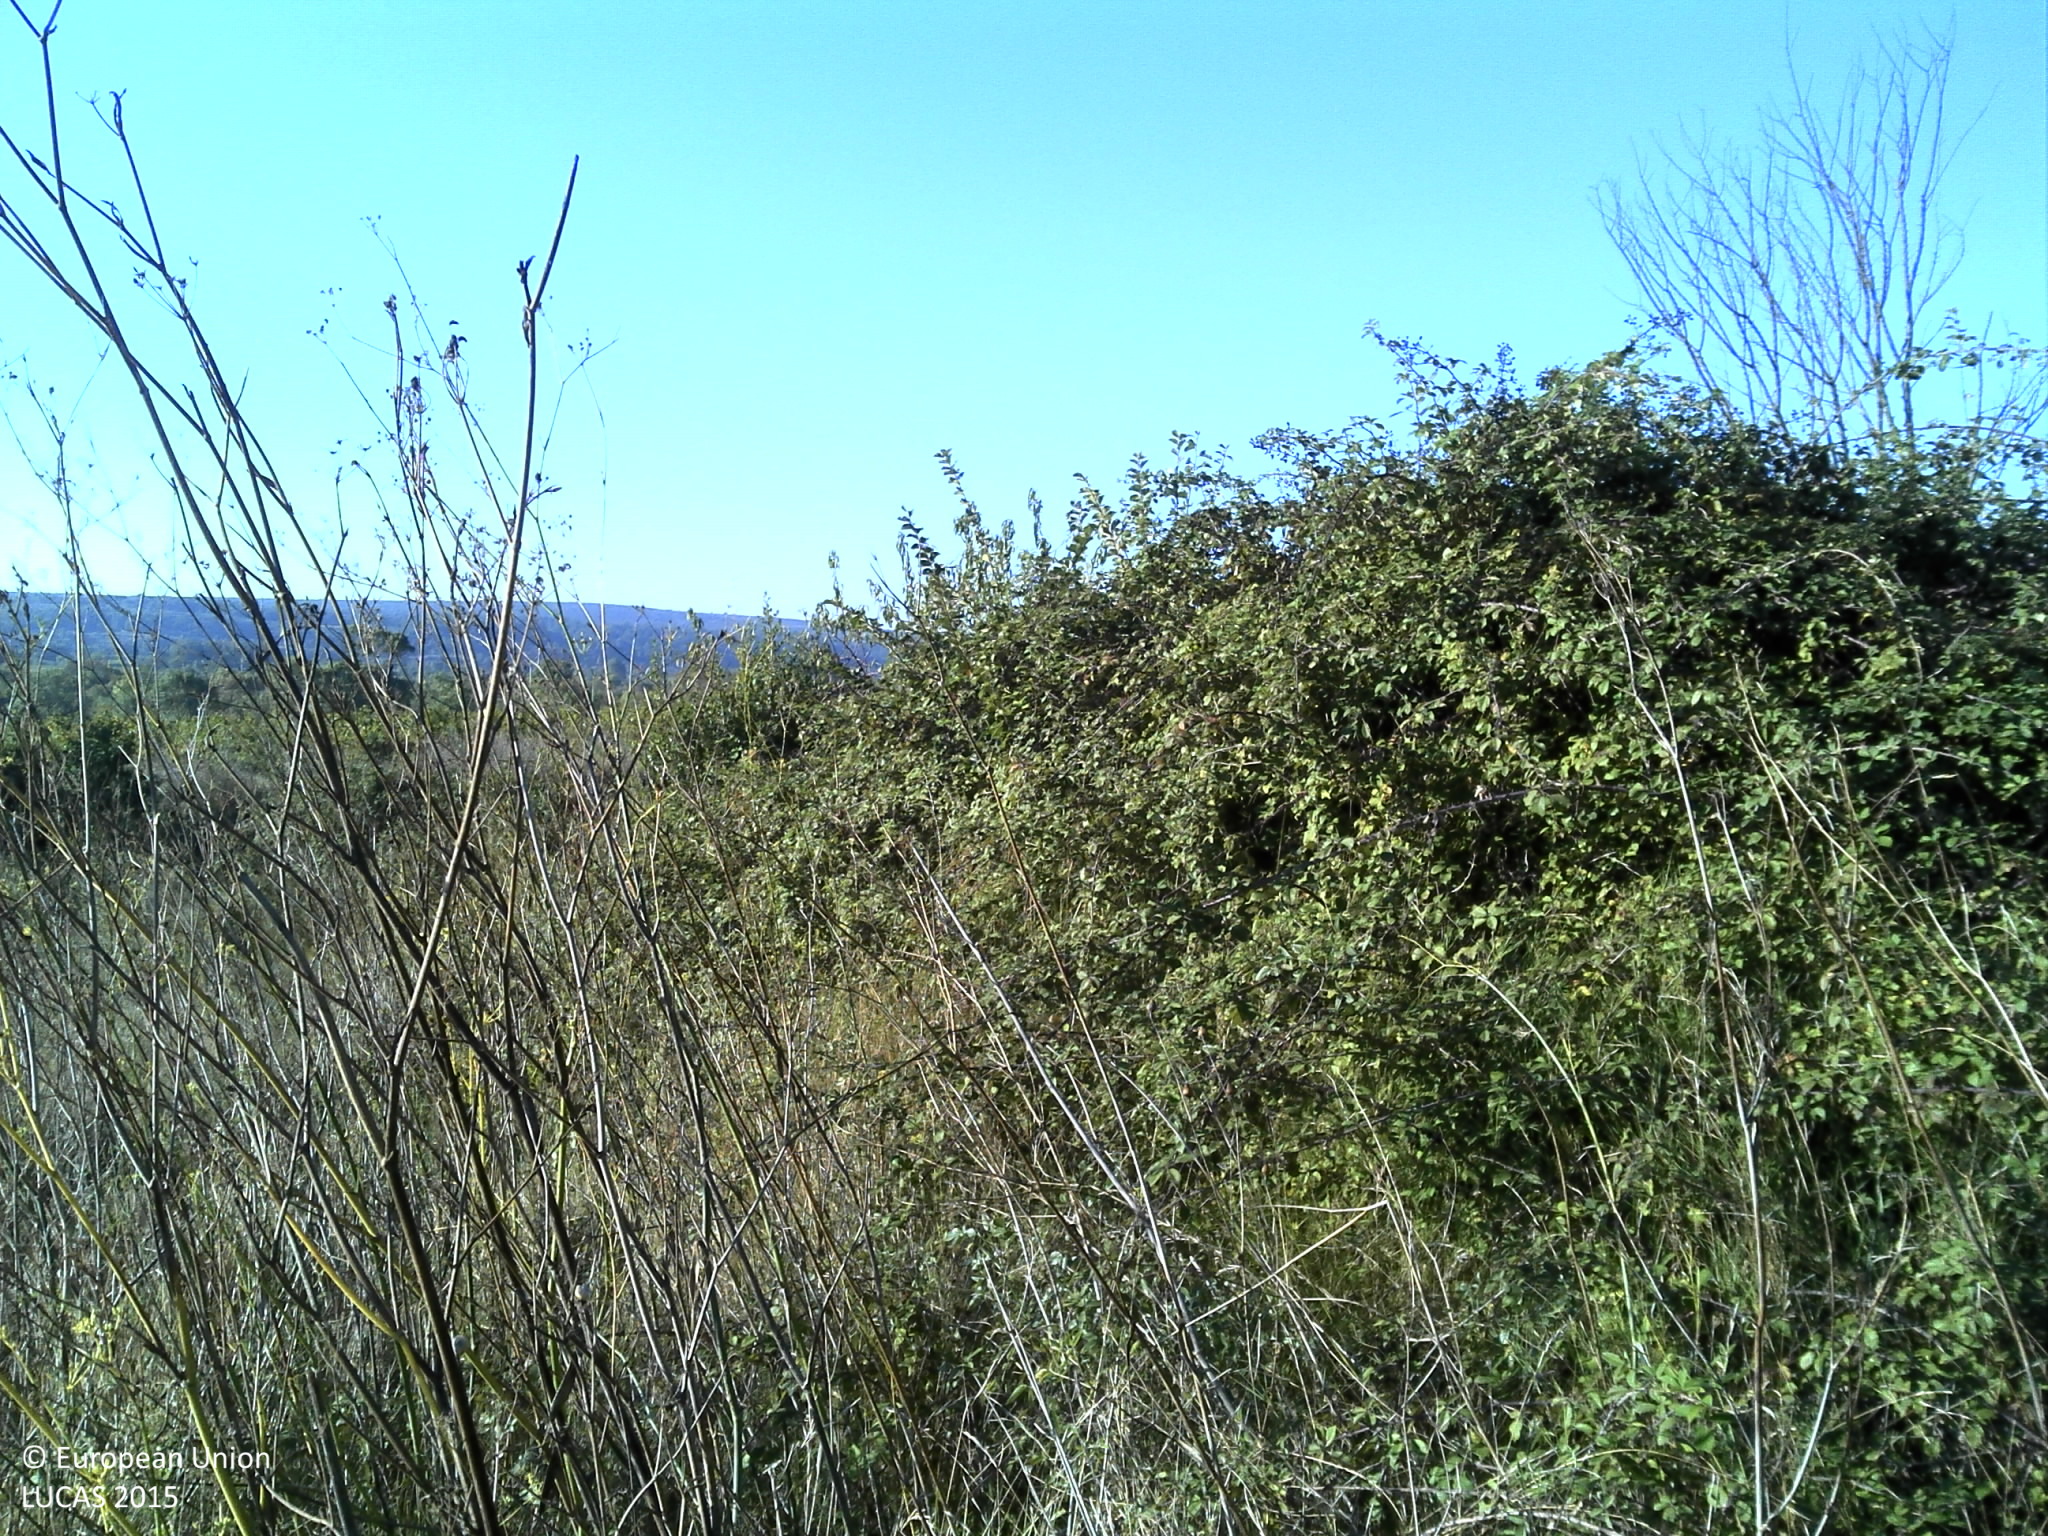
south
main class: Shrubland
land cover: Shrubland with sparse tree cover
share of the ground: > 75 %
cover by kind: shrubs 85 %, herbaceous plants 10 %, broadleaved forest trees 5 %
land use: Semi-natural and natural areas not in use
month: October
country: FR
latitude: 43.2567
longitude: 3.1732
